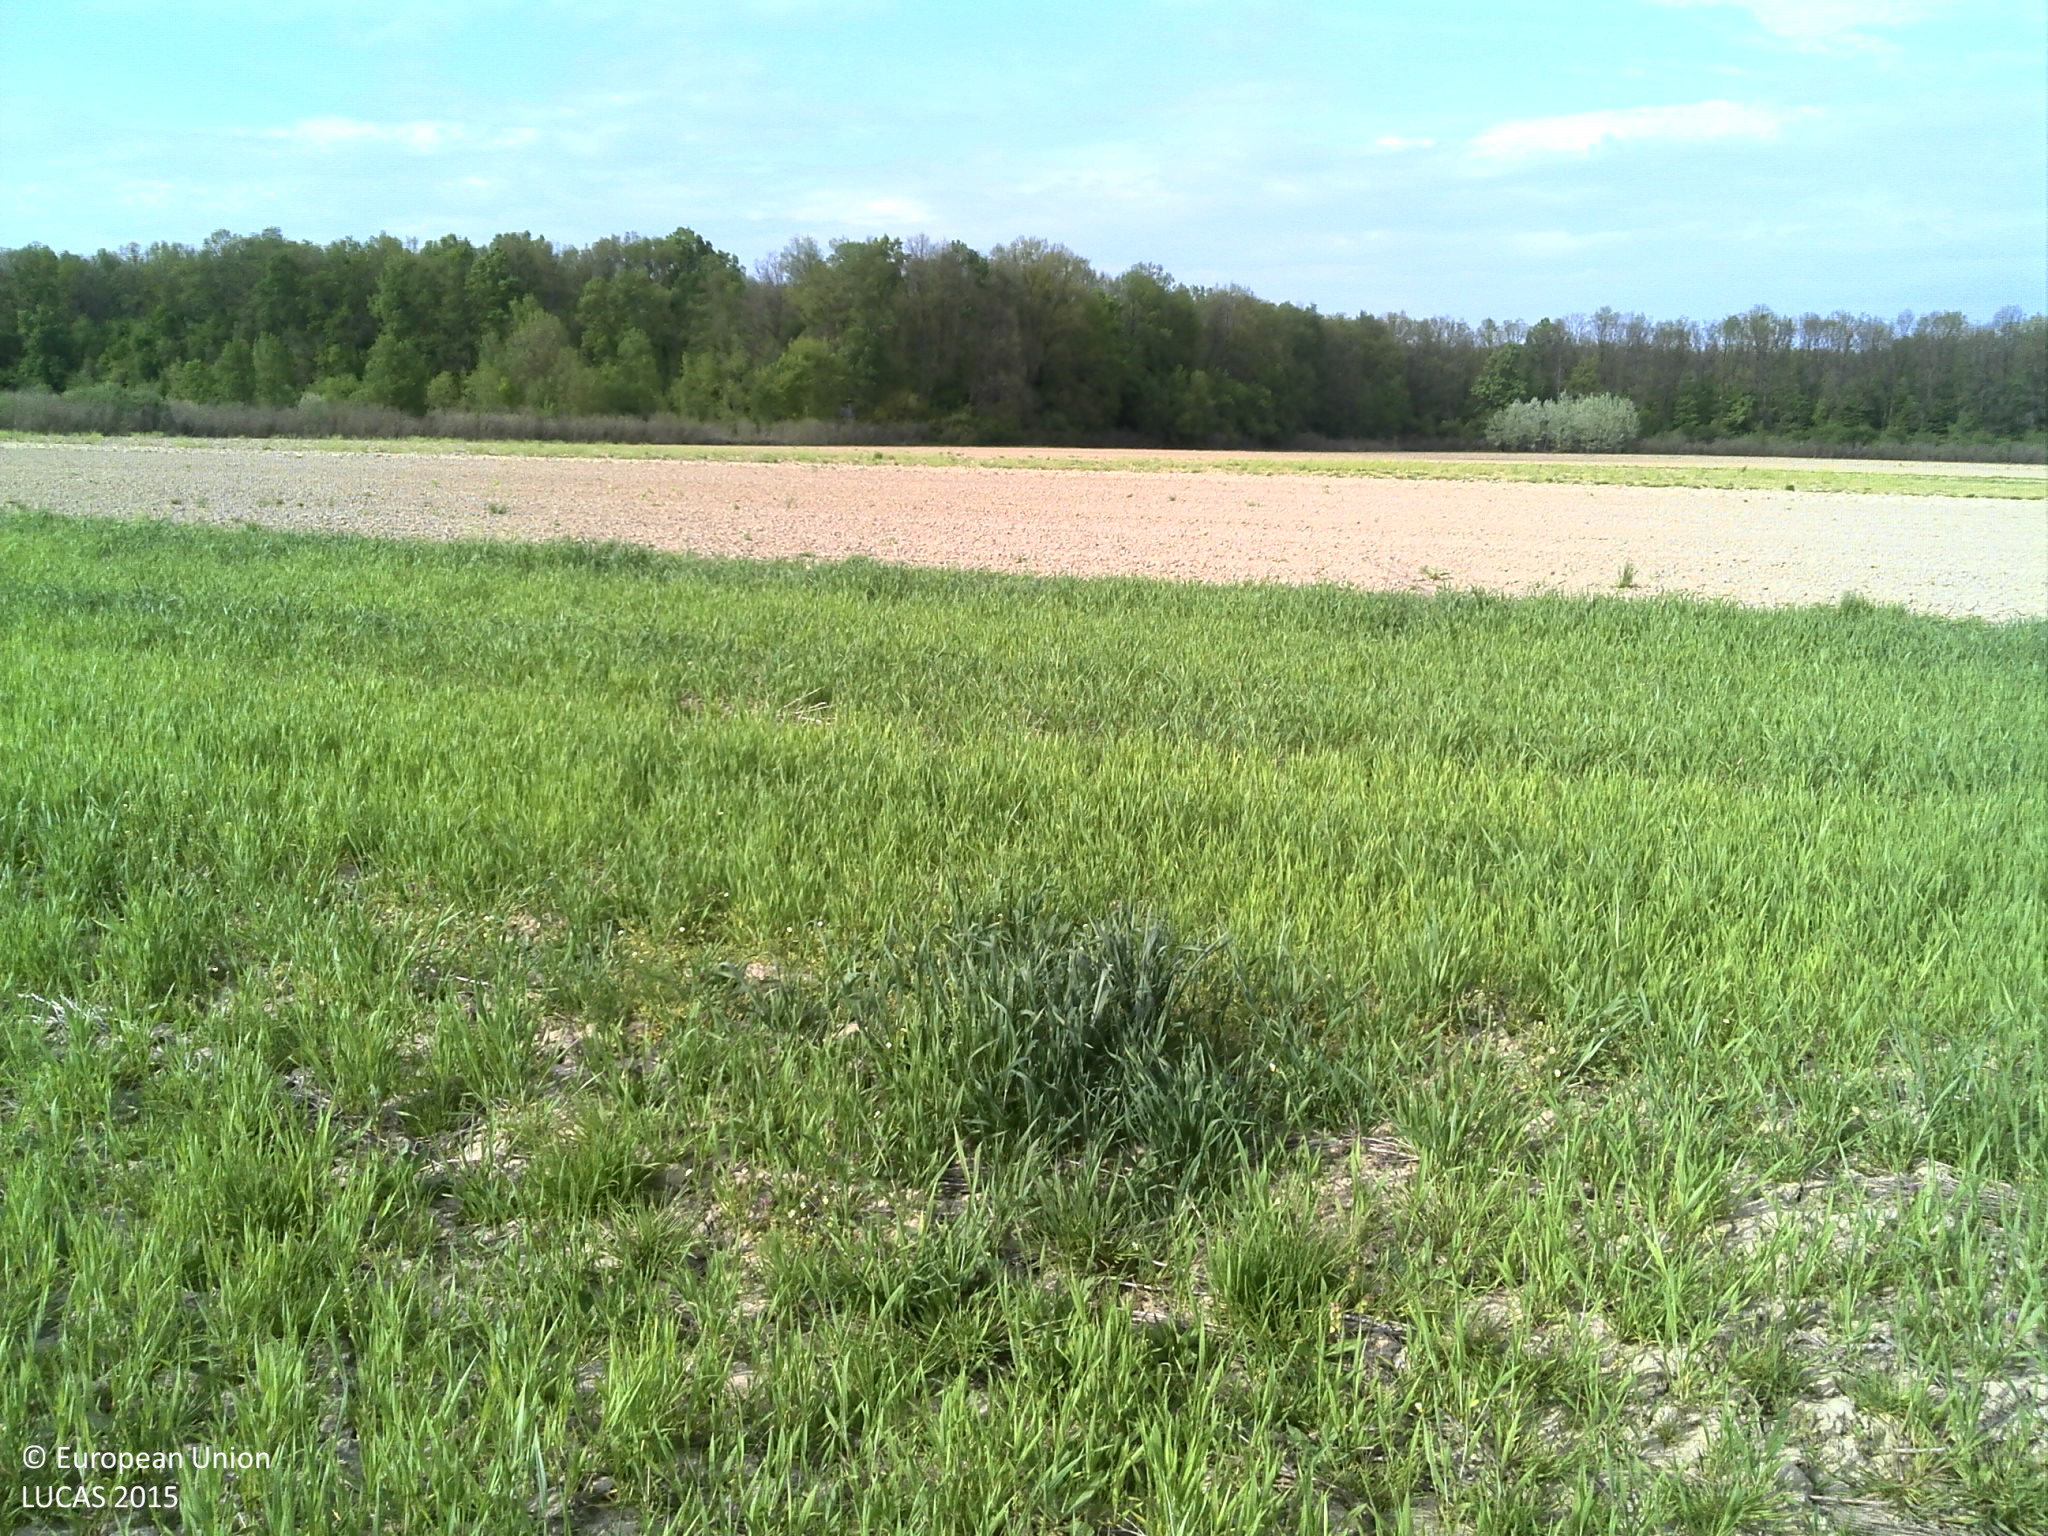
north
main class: Cropland
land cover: Common wheat
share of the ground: > 75 %
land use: Agriculture (excluding fallow land and kitchen gardens)
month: April
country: HR
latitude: 45.0633
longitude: 18.8072
